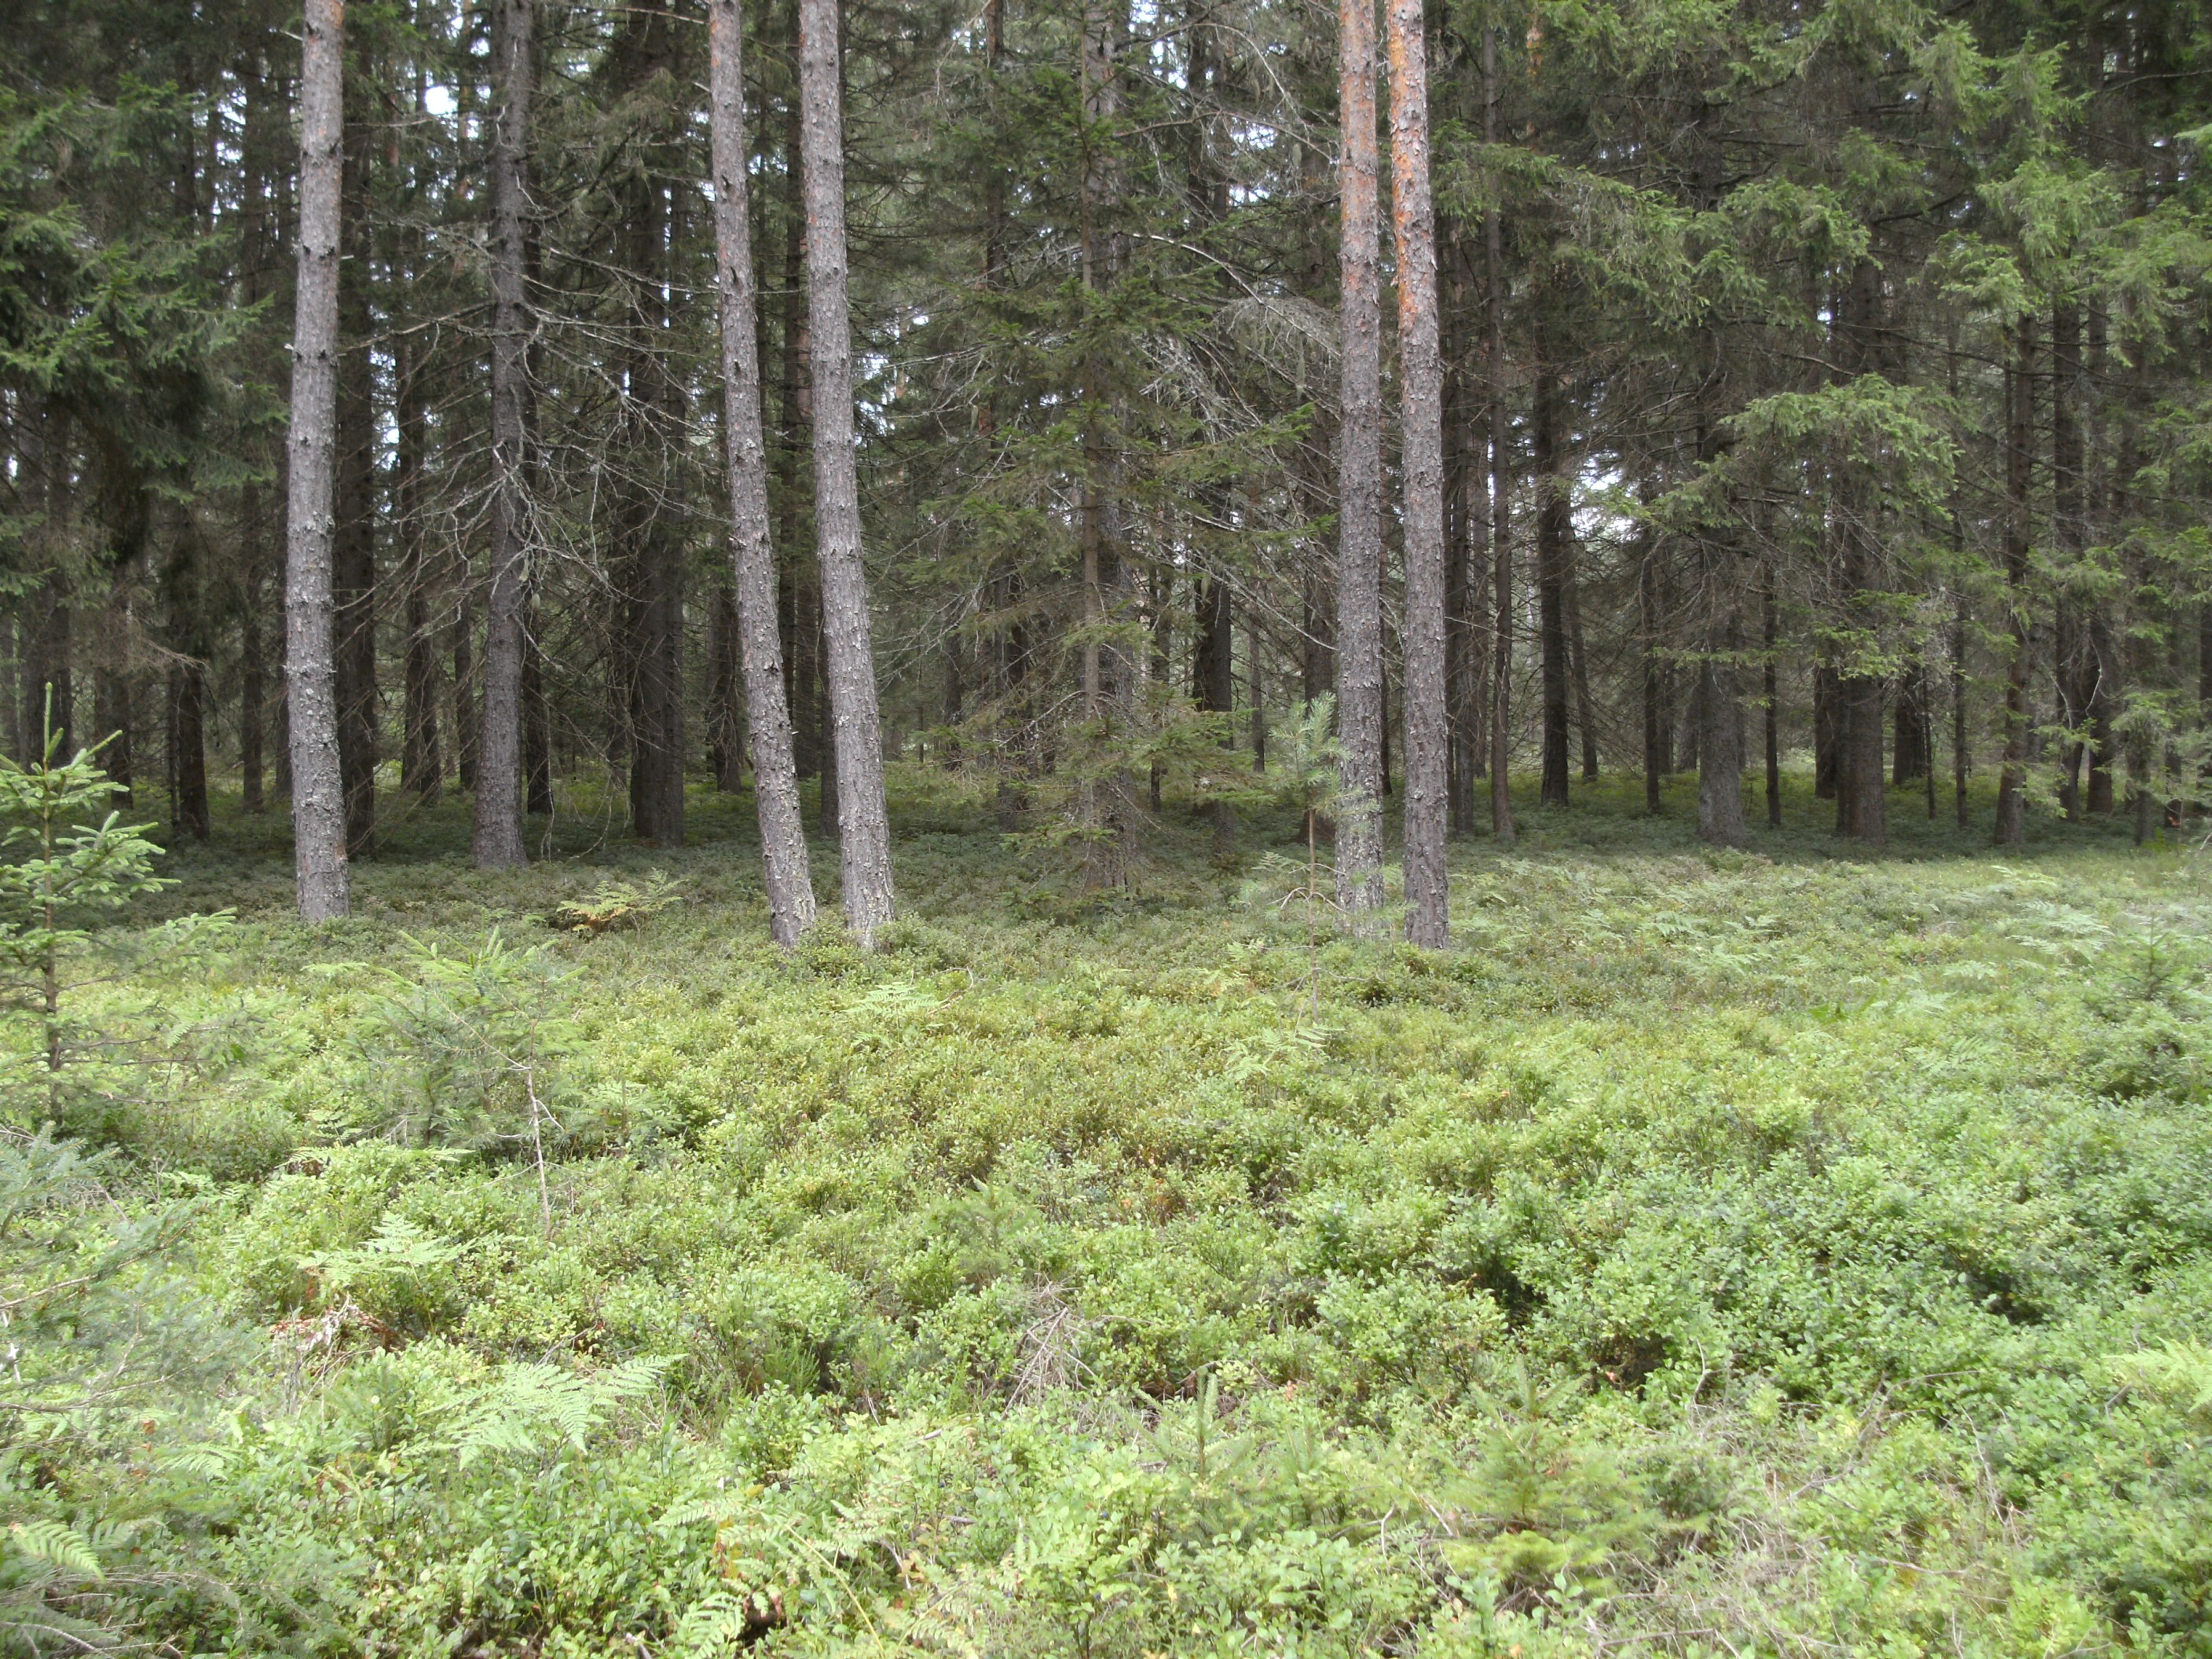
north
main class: Woodland
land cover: Pine dominated coniferous woodland
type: hemiboreal forest and nemoral coniferous forest and mixed broadleaved-coniferous forest
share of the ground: 25 - 50 %
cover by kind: shrubs 50 %, coniferous forest trees 40 %, herbaceous plants 5 %, lichens and mosses 5 %
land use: Forestry
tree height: > 5 m
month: July
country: AT
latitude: 46.5914
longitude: 14.6834
